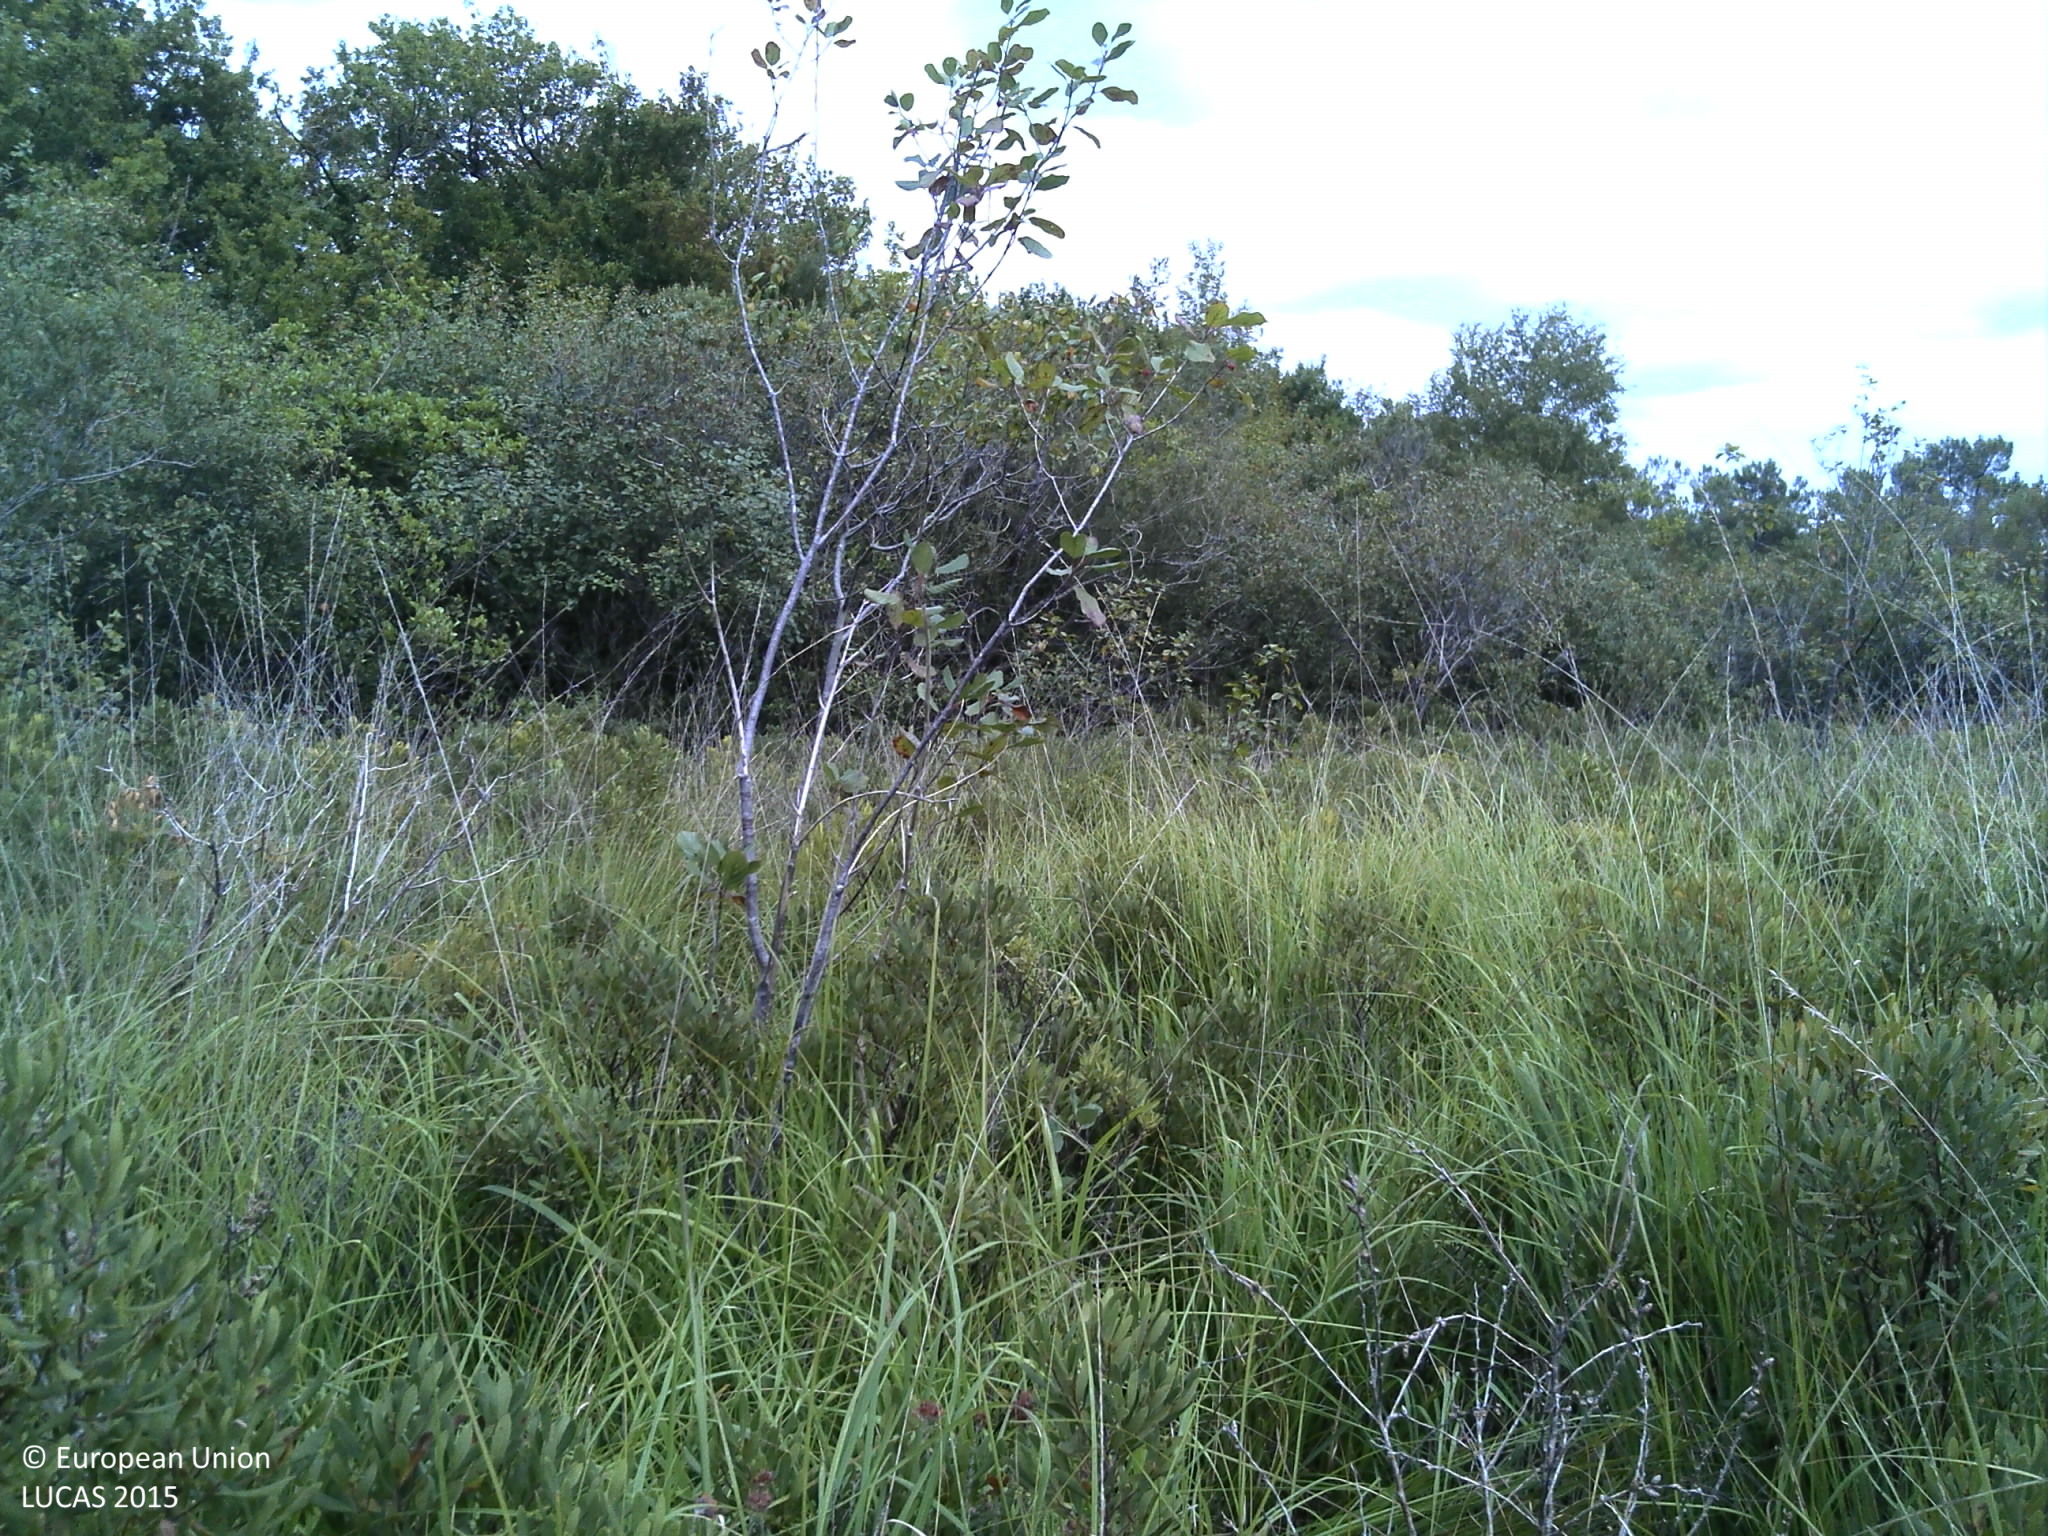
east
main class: Shrubland
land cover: Shrubland without tree cover
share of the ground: > 75 %
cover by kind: shrubs 80 %, herbaceous plants 20 %
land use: Semi-natural and natural areas not in use
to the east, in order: Shrubland without tree cover; Broadleaved woodland; Shrubland with sparse tree cover; Pine dominated coniferous woodland
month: August
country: FR
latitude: 44.6216
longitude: -0.9732
